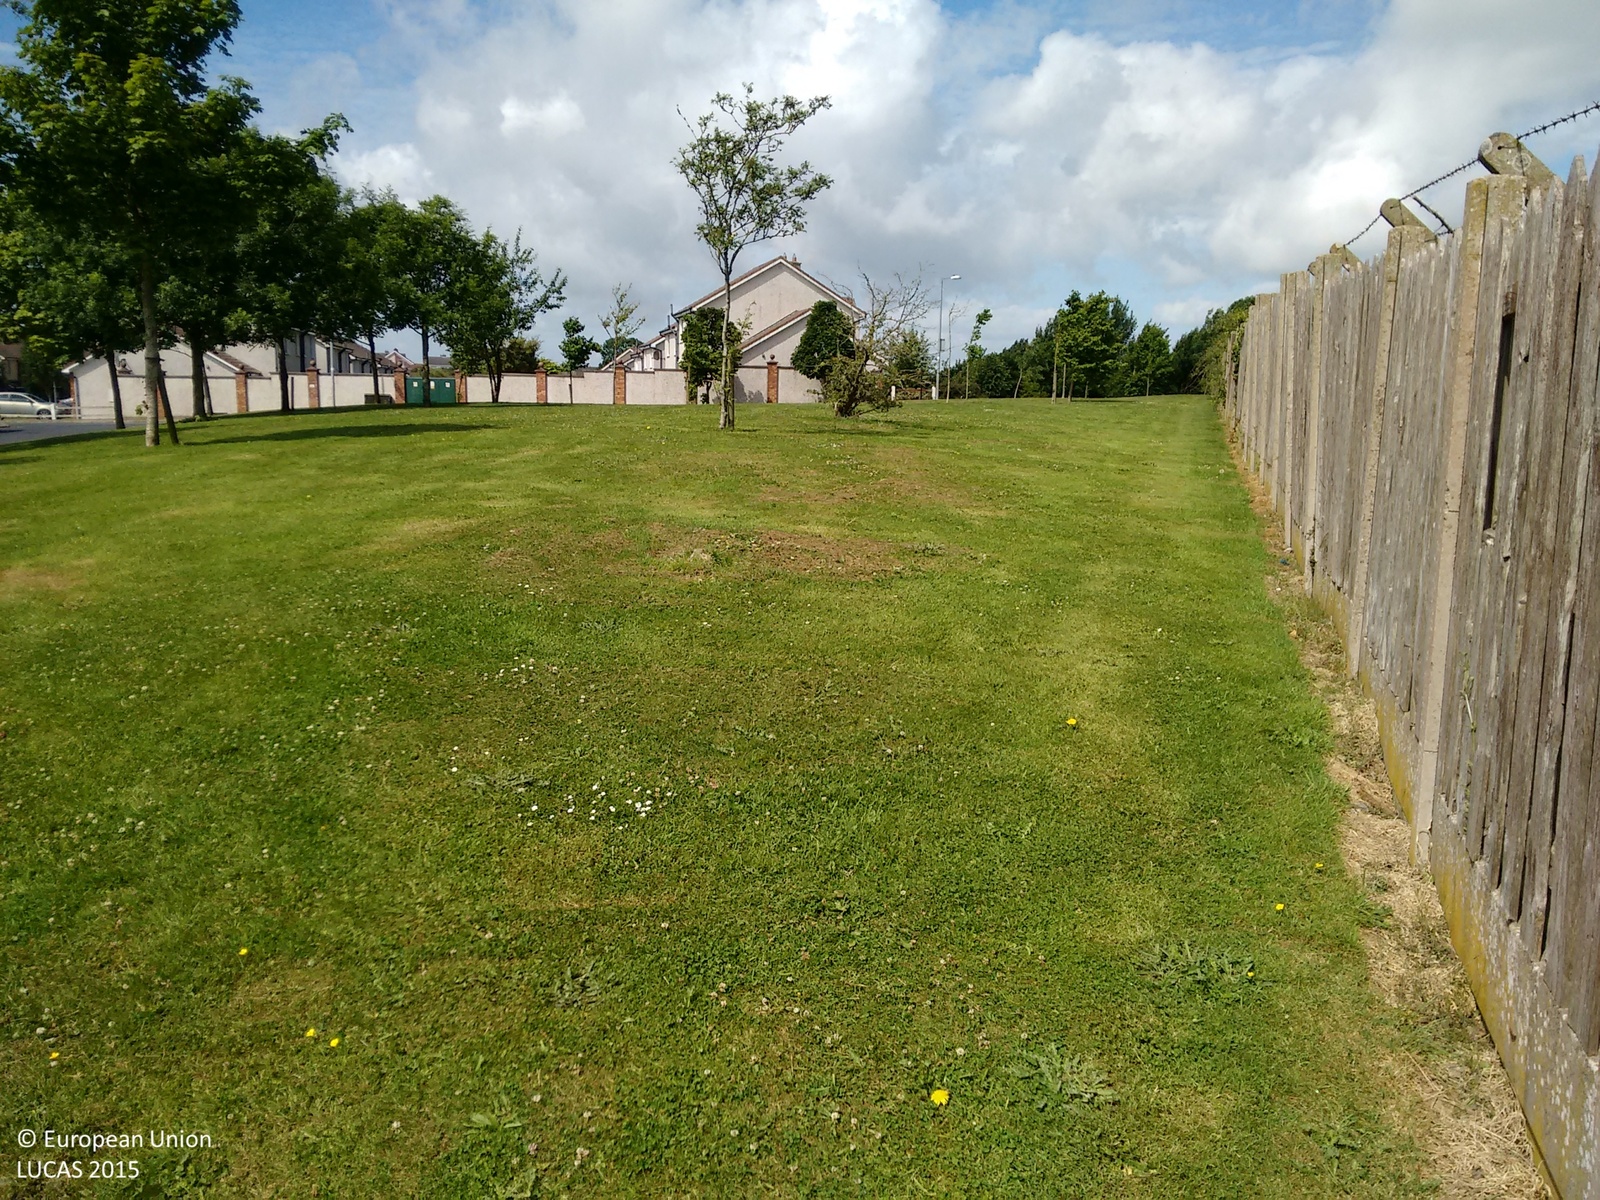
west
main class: Grassland
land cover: Grassland without tree/shrub cover
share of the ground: > 75 %
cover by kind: herbaceous plants 100 %
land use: Semi-natural and natural areas not in use
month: June
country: IE
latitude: 52.2468
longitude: -7.0921
